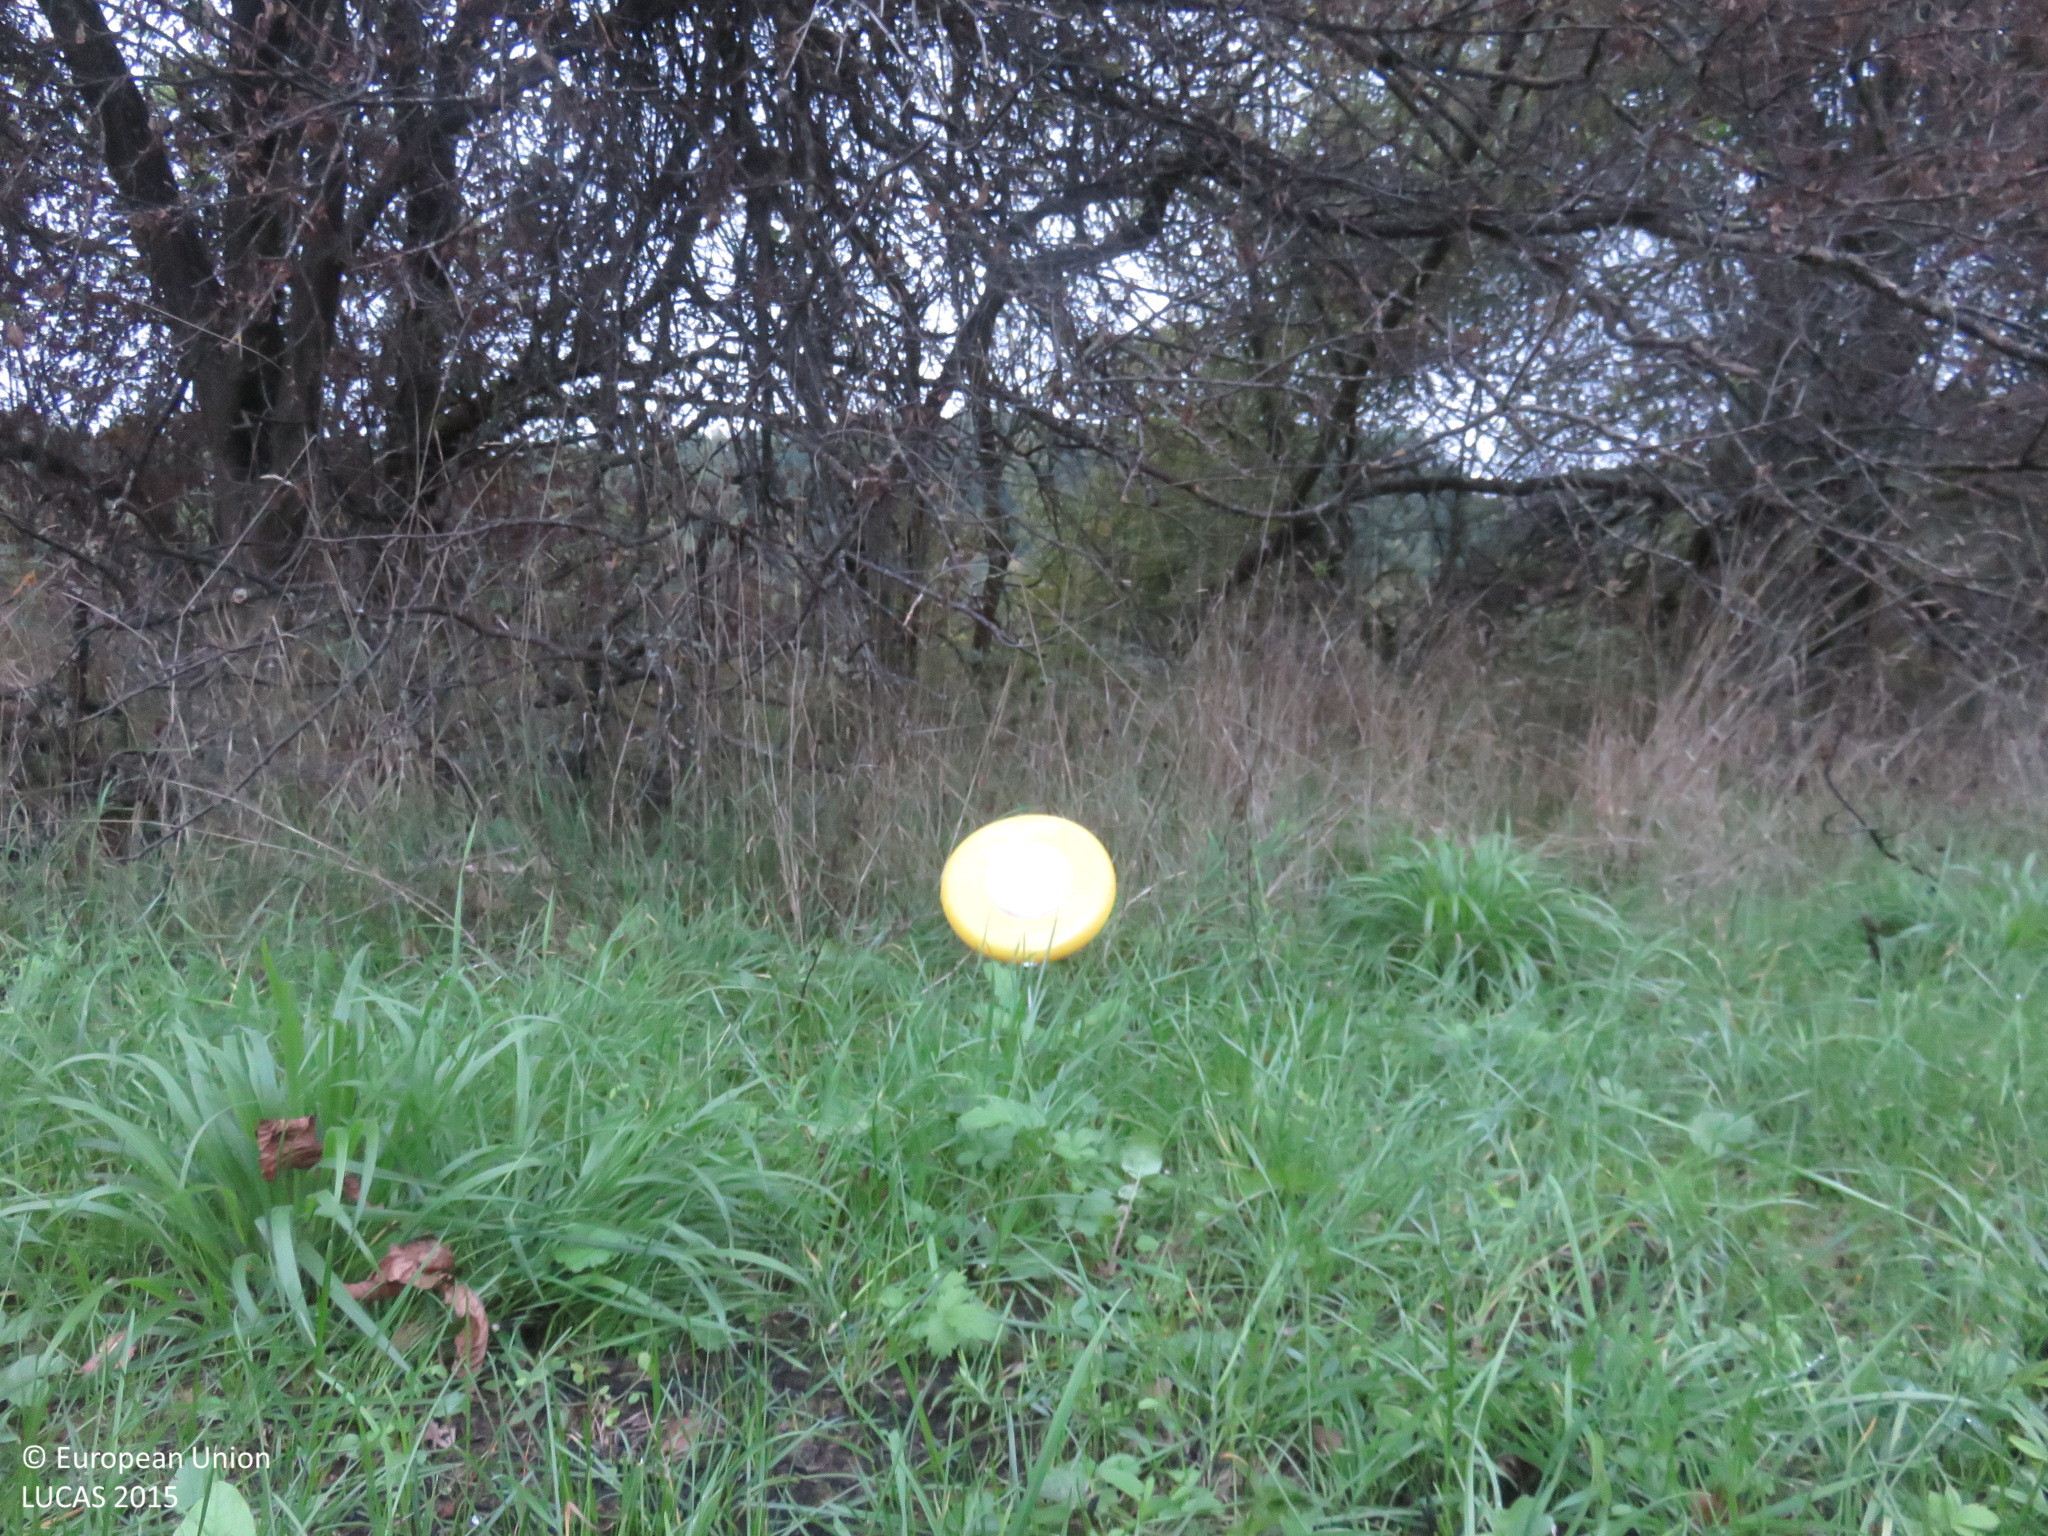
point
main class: Grassland
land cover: Grassland without tree/shrub cover
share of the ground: > 75 %
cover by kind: herbaceous plants 100 %
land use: Agriculture (excluding fallow land and kitchen gardens)
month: October
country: BG
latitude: 42.9539
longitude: 25.2826
